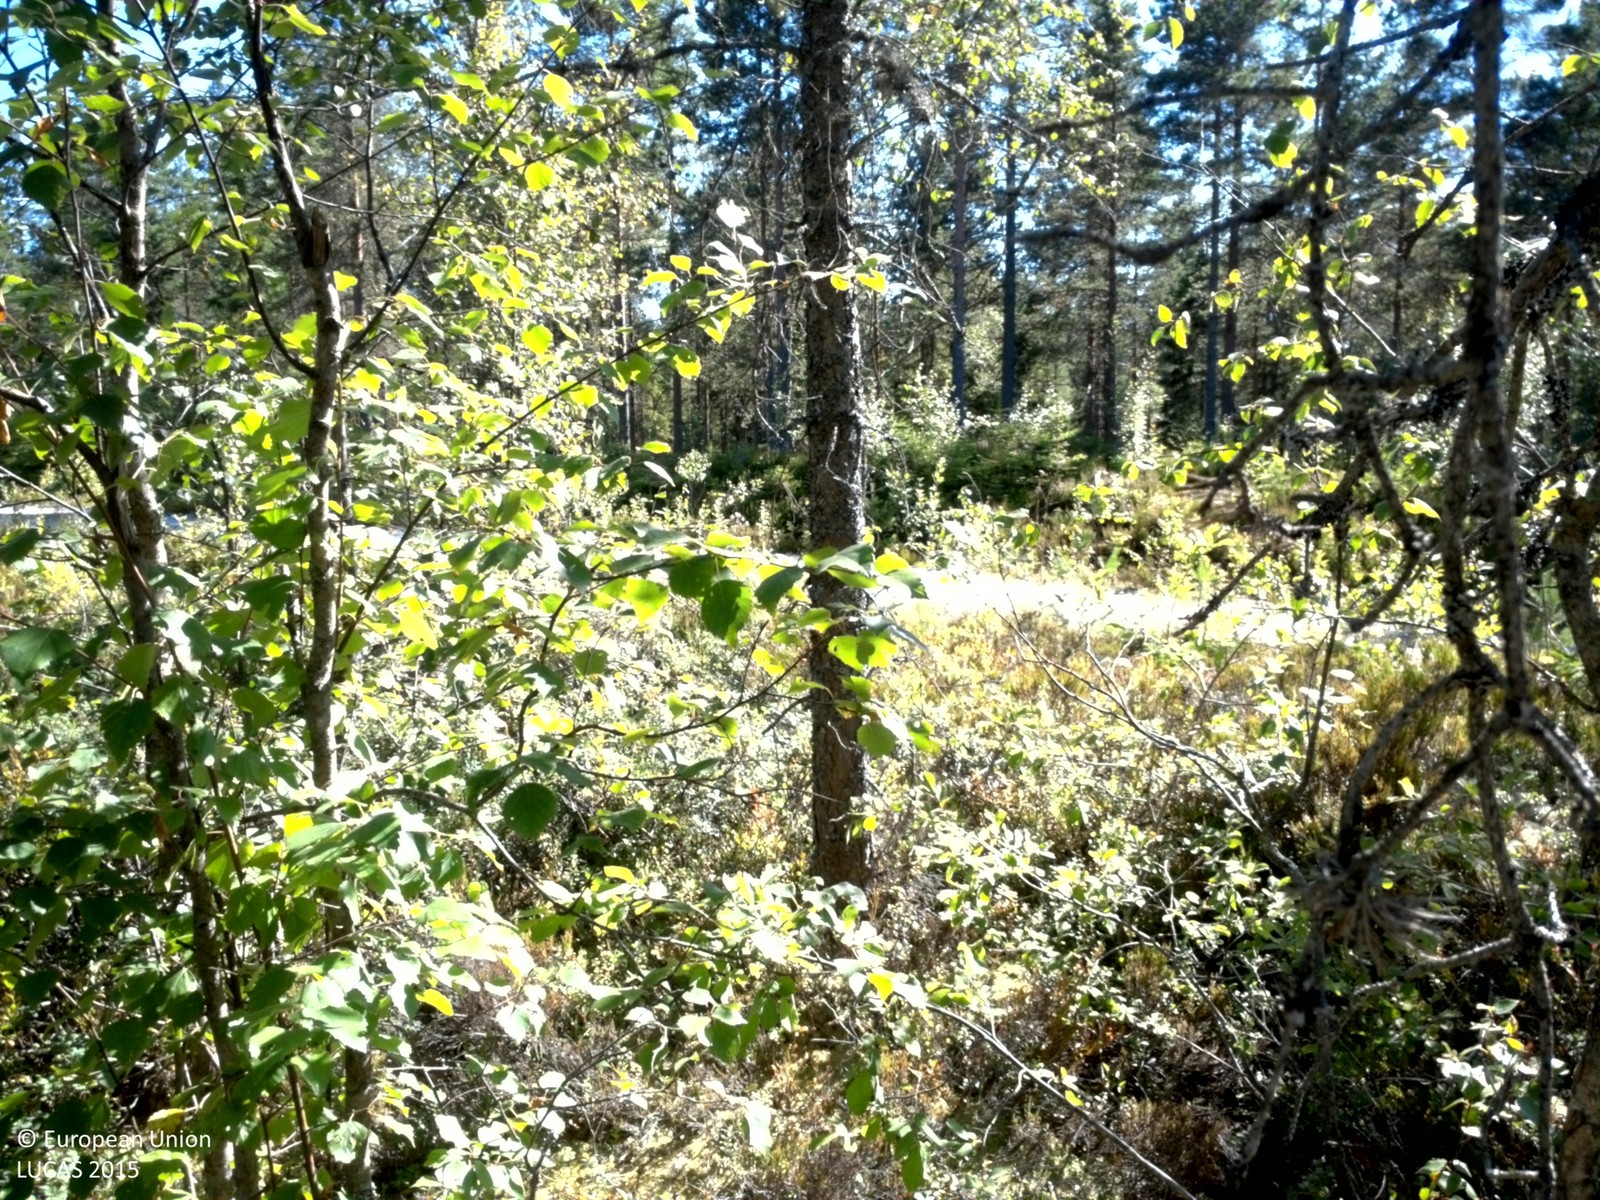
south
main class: Woodland
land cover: Other coniferous woodland
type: boreal forest
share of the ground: 50 - 75 %
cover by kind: coniferous forest trees 60 %, shrubs 30 %, broadleaved forest trees 5 %, lichens and mosses 5 %
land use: Forestry
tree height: > 5 m
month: August
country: SE
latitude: 59.9391
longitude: 14.1601
